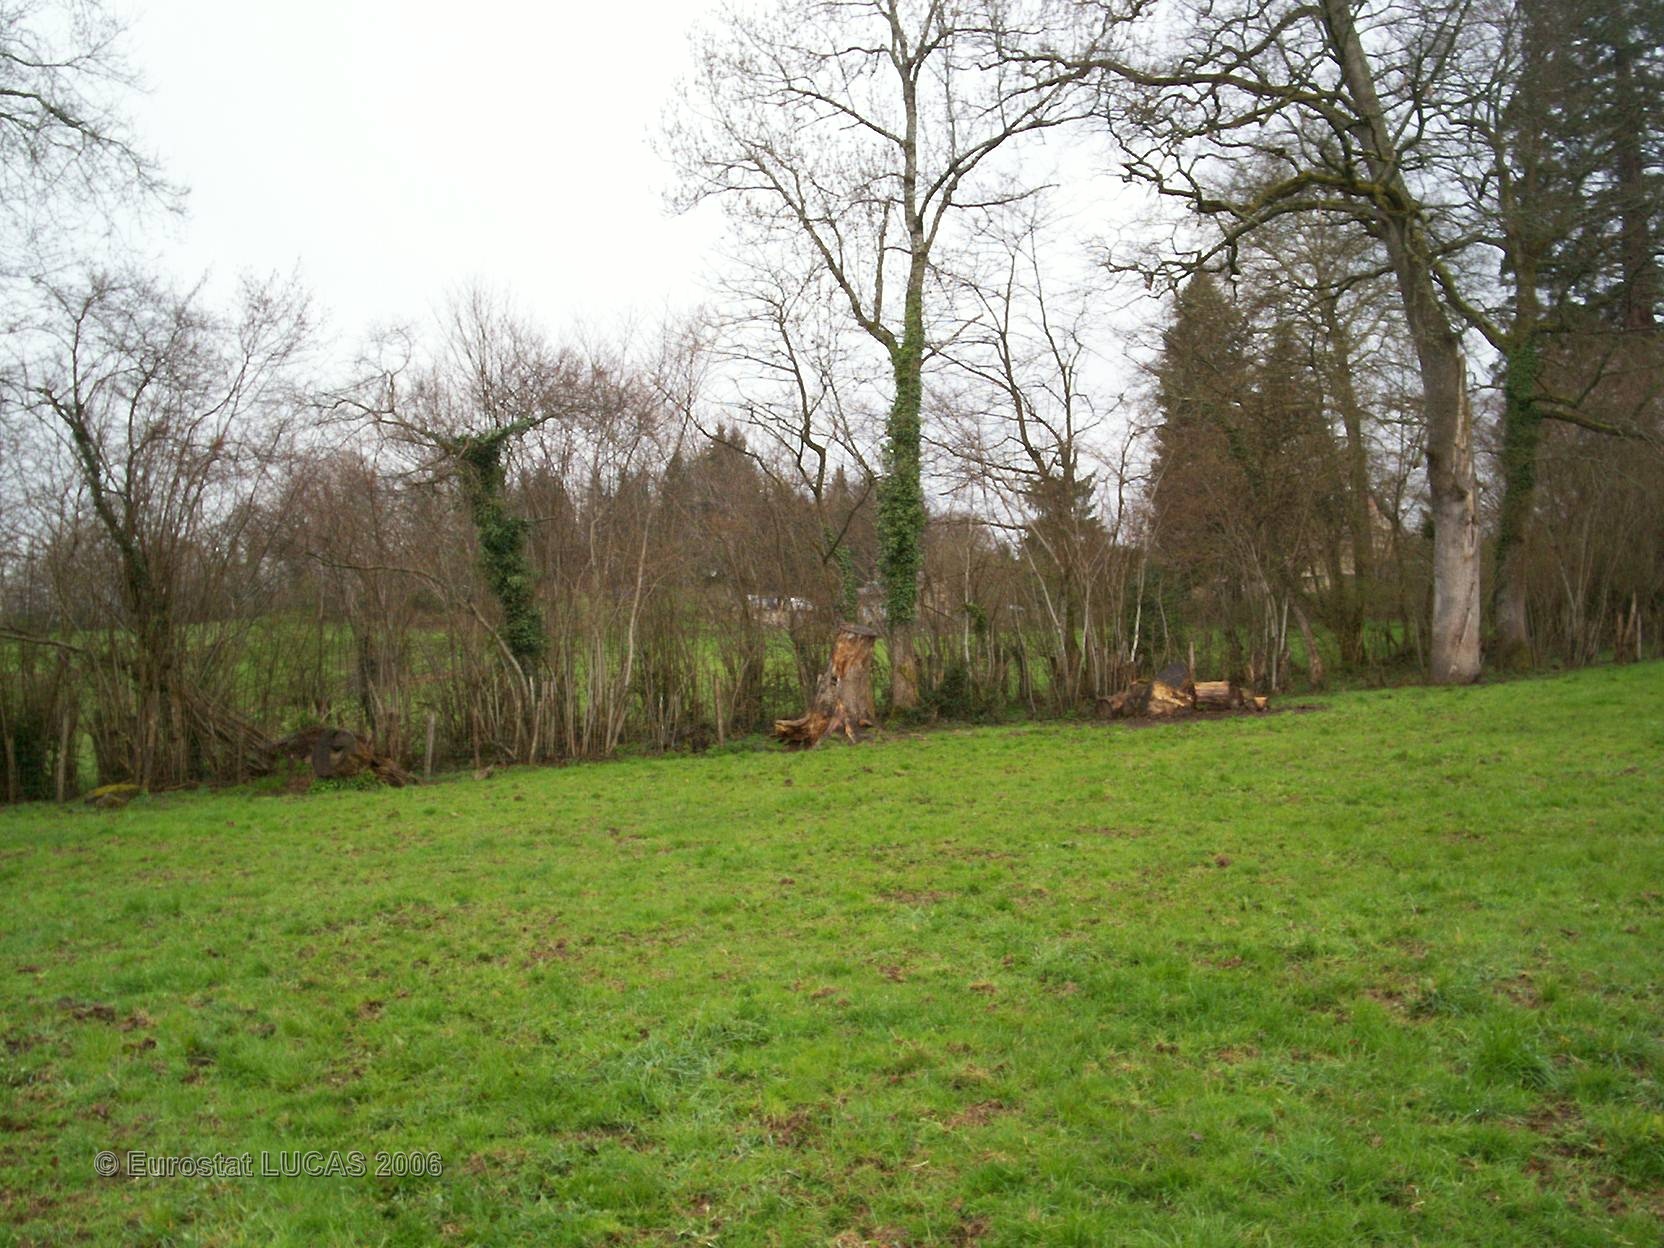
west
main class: Grassland
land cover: Grassland without tree/shrub cover
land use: Agriculture (excluding fallow land and kitchen gardens)
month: April
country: FR
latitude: 45.4763
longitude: 1.5897
